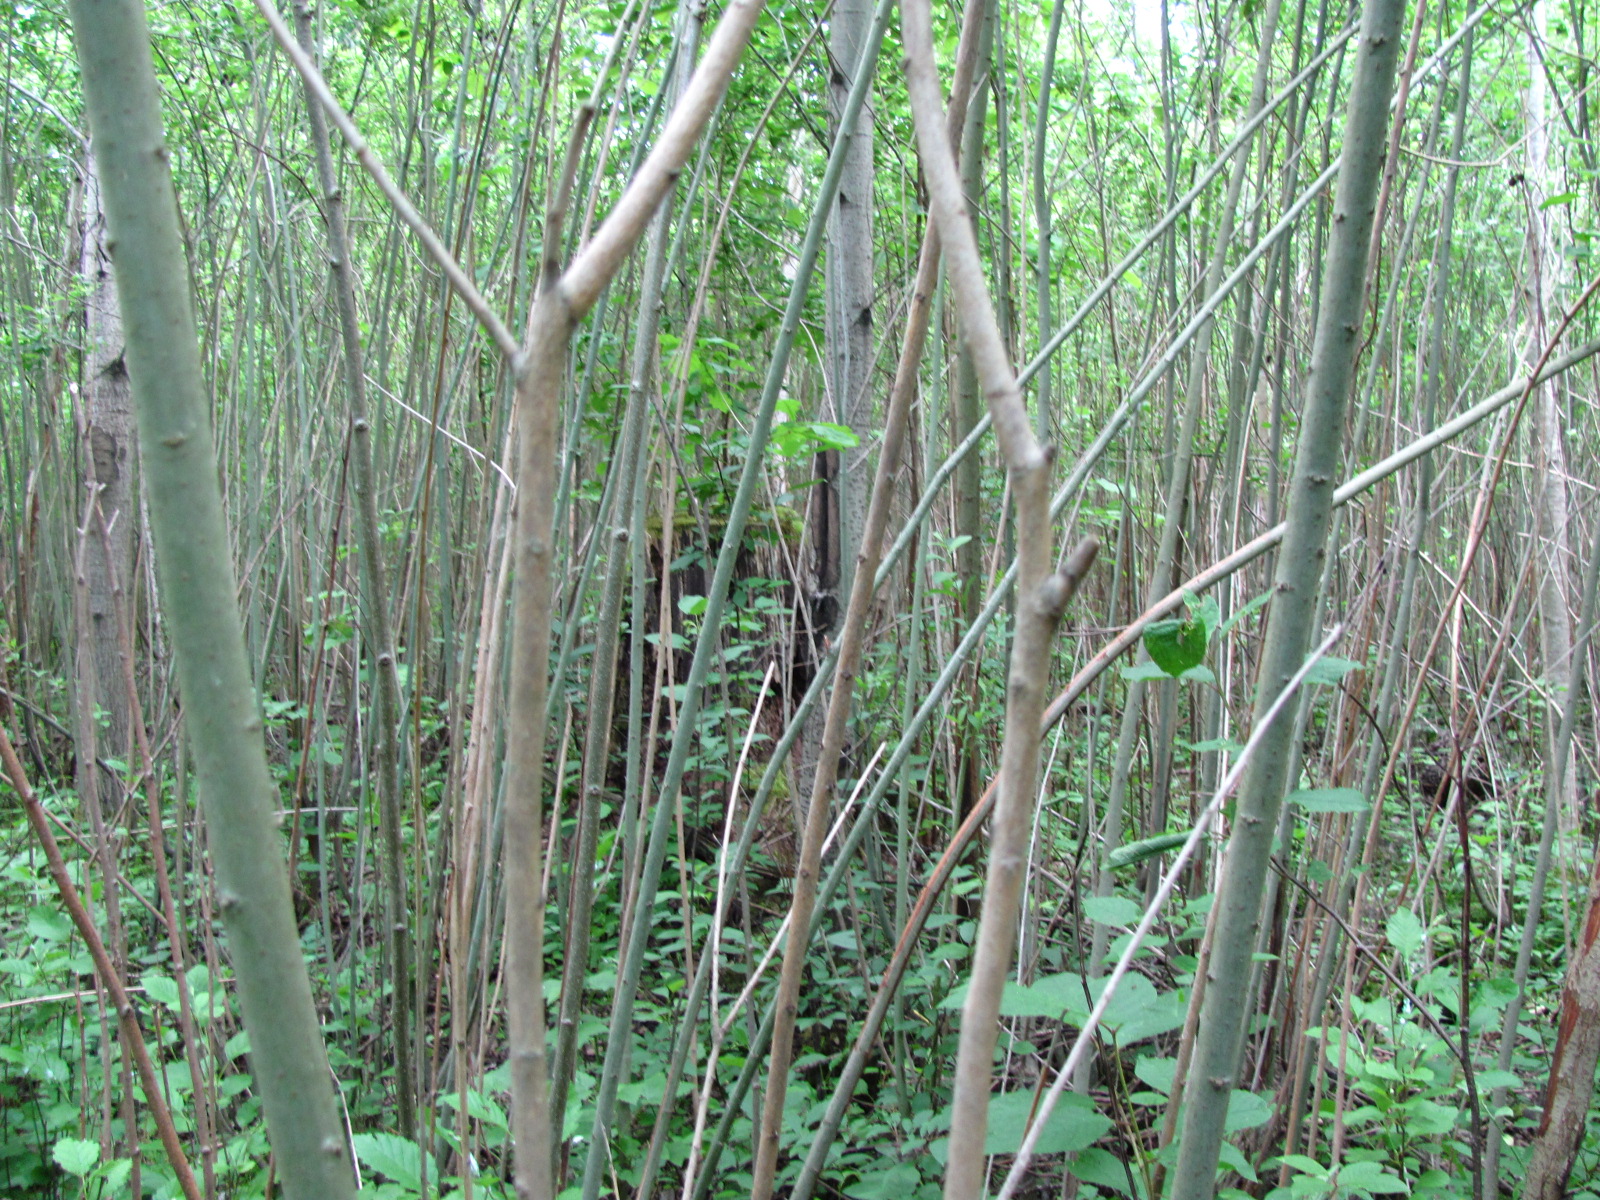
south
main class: Woodland
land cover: Broadleaved woodland
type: non-riverine alder, birch or aspen forest
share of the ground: > 75 %
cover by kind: broadleaved forest trees 100 %
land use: Forestry
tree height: > 5 m
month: June
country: LV
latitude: 56.3421
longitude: 24.2138
